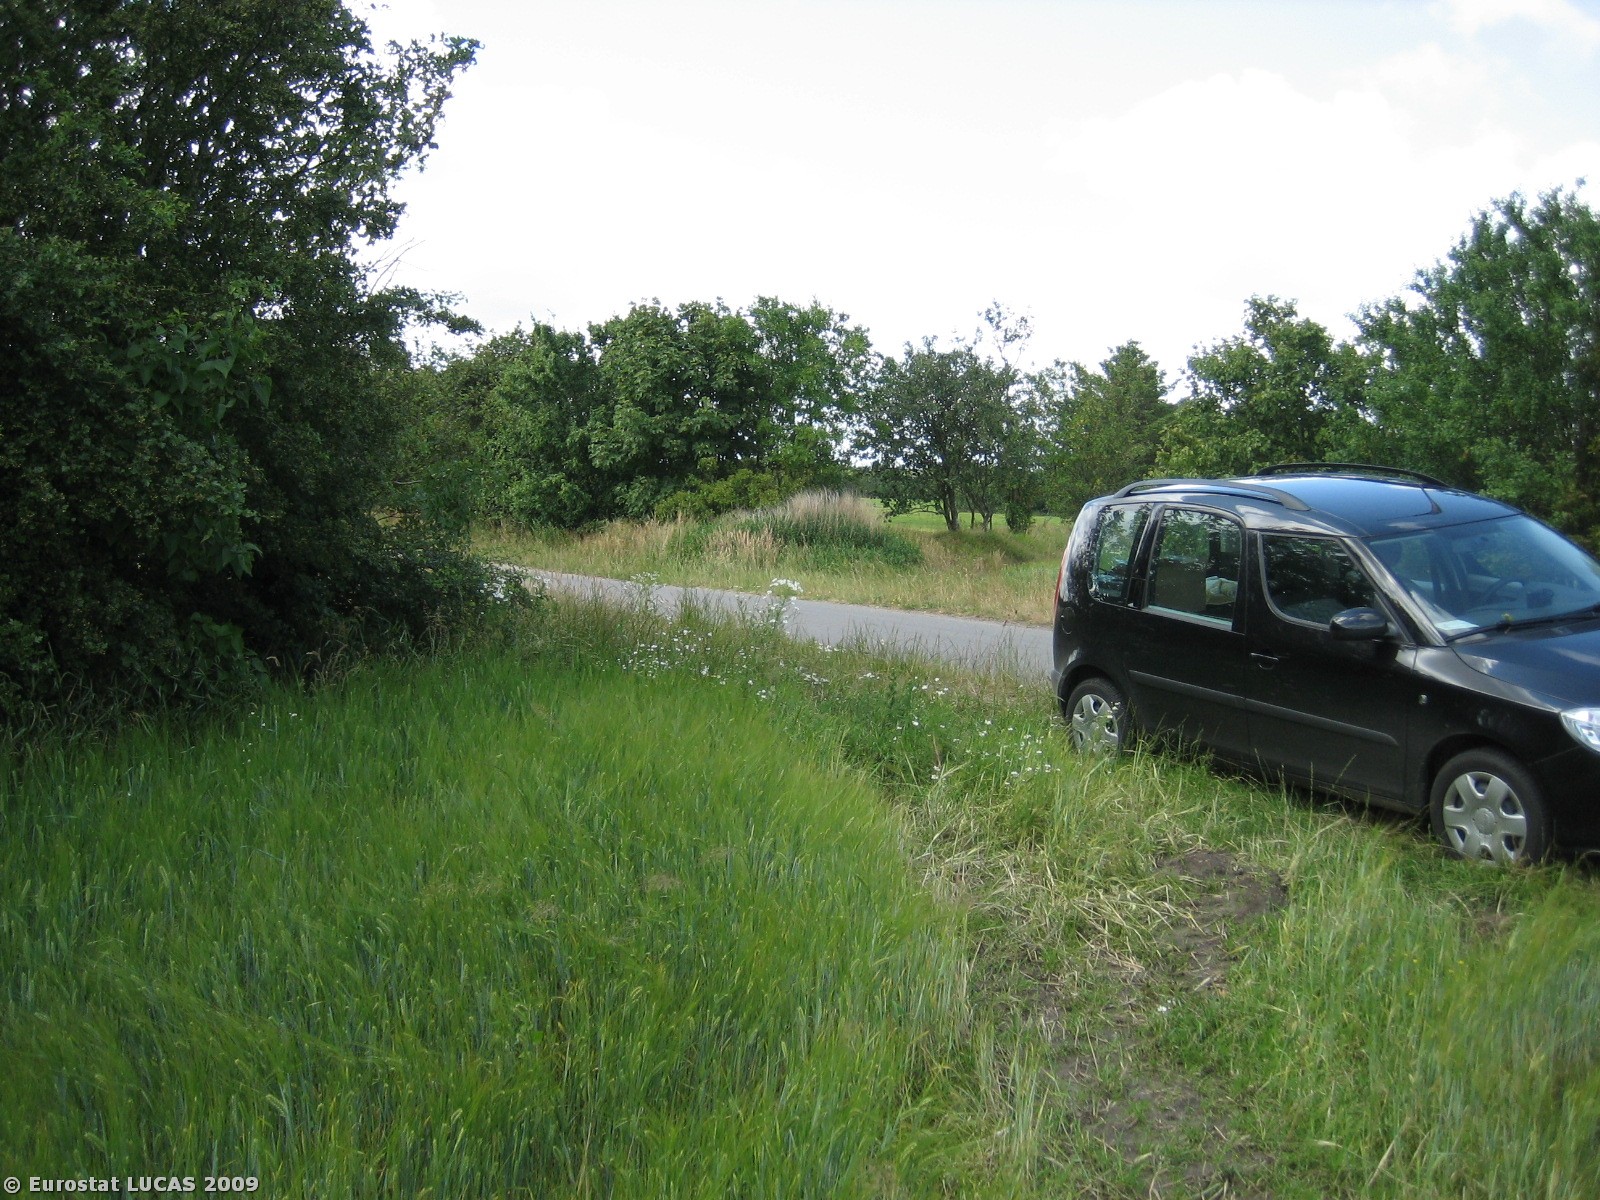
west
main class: Cropland
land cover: Barley
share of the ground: > 75 %
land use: Agriculture (excluding fallow land and kitchen gardens)
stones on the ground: < 10 %
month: July
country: DK
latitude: 55.6942
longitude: 8.5536
